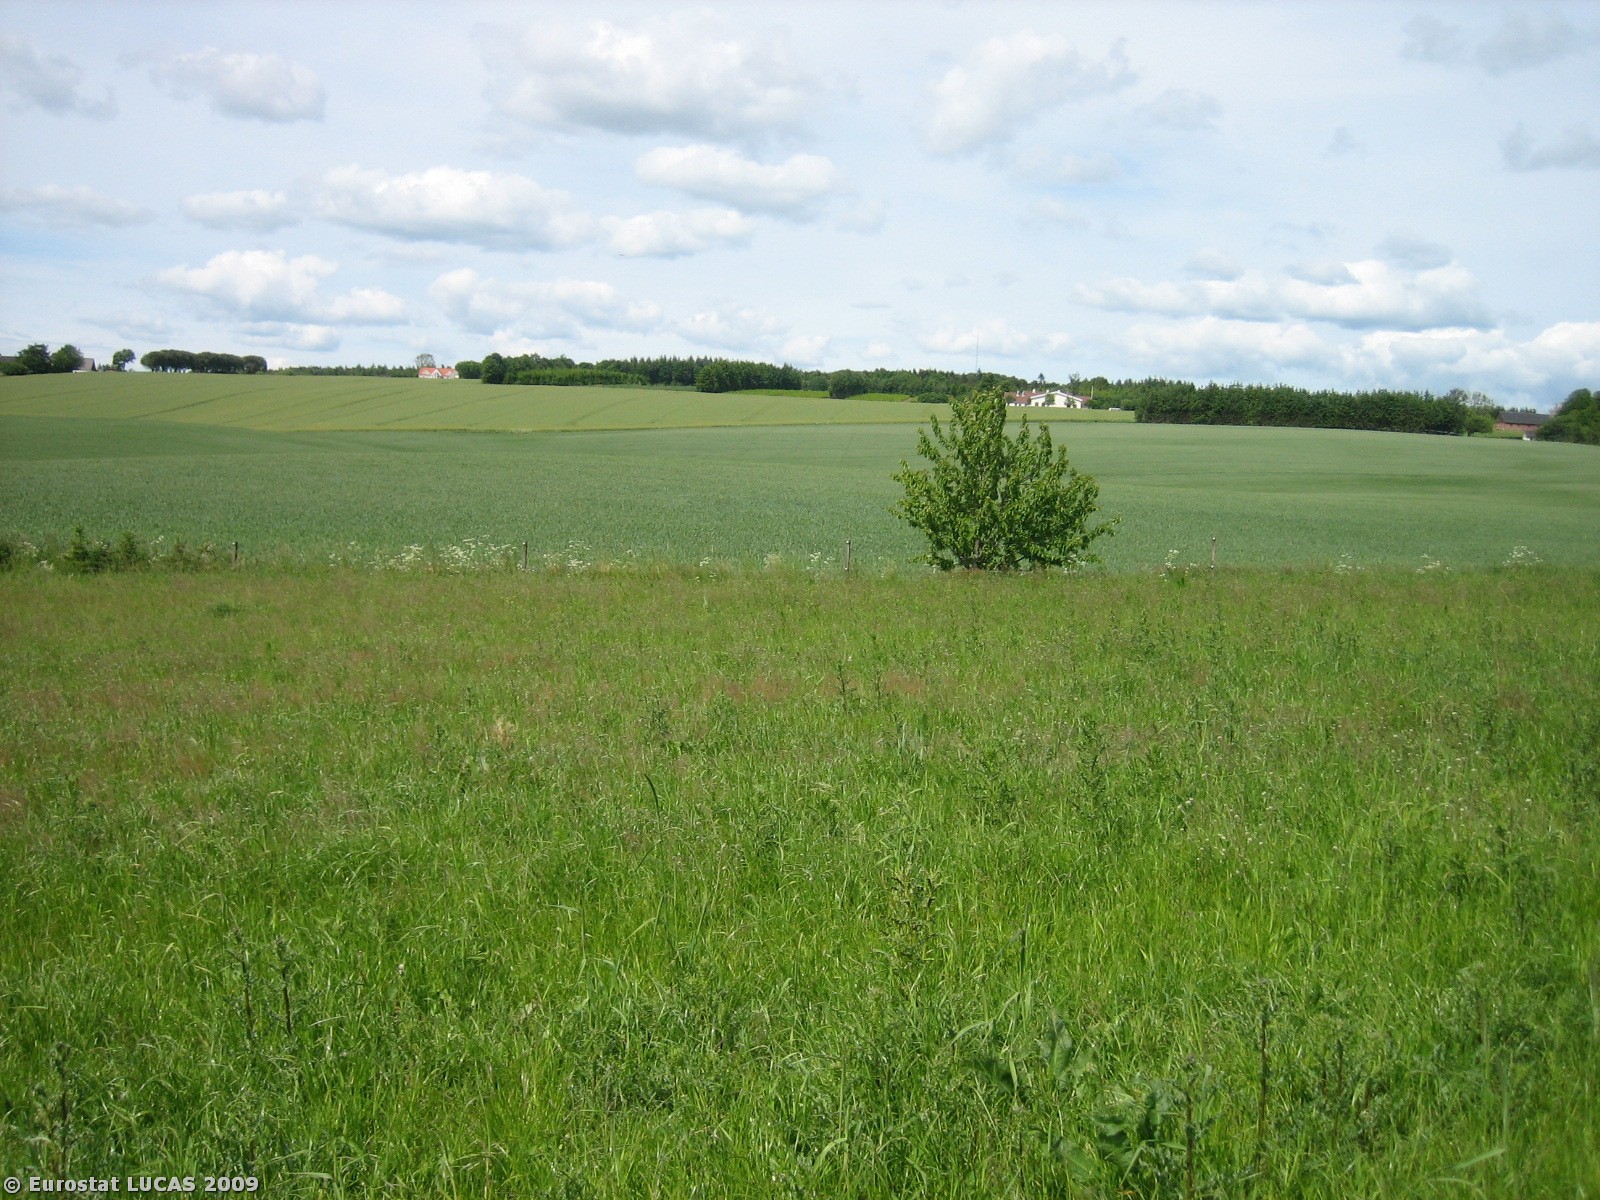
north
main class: Grassland
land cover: Grassland without tree/shrub cover
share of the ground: > 75 %
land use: Agriculture (excluding fallow land and kitchen gardens)
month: June
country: DK
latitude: 56.1875
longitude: 9.7586
